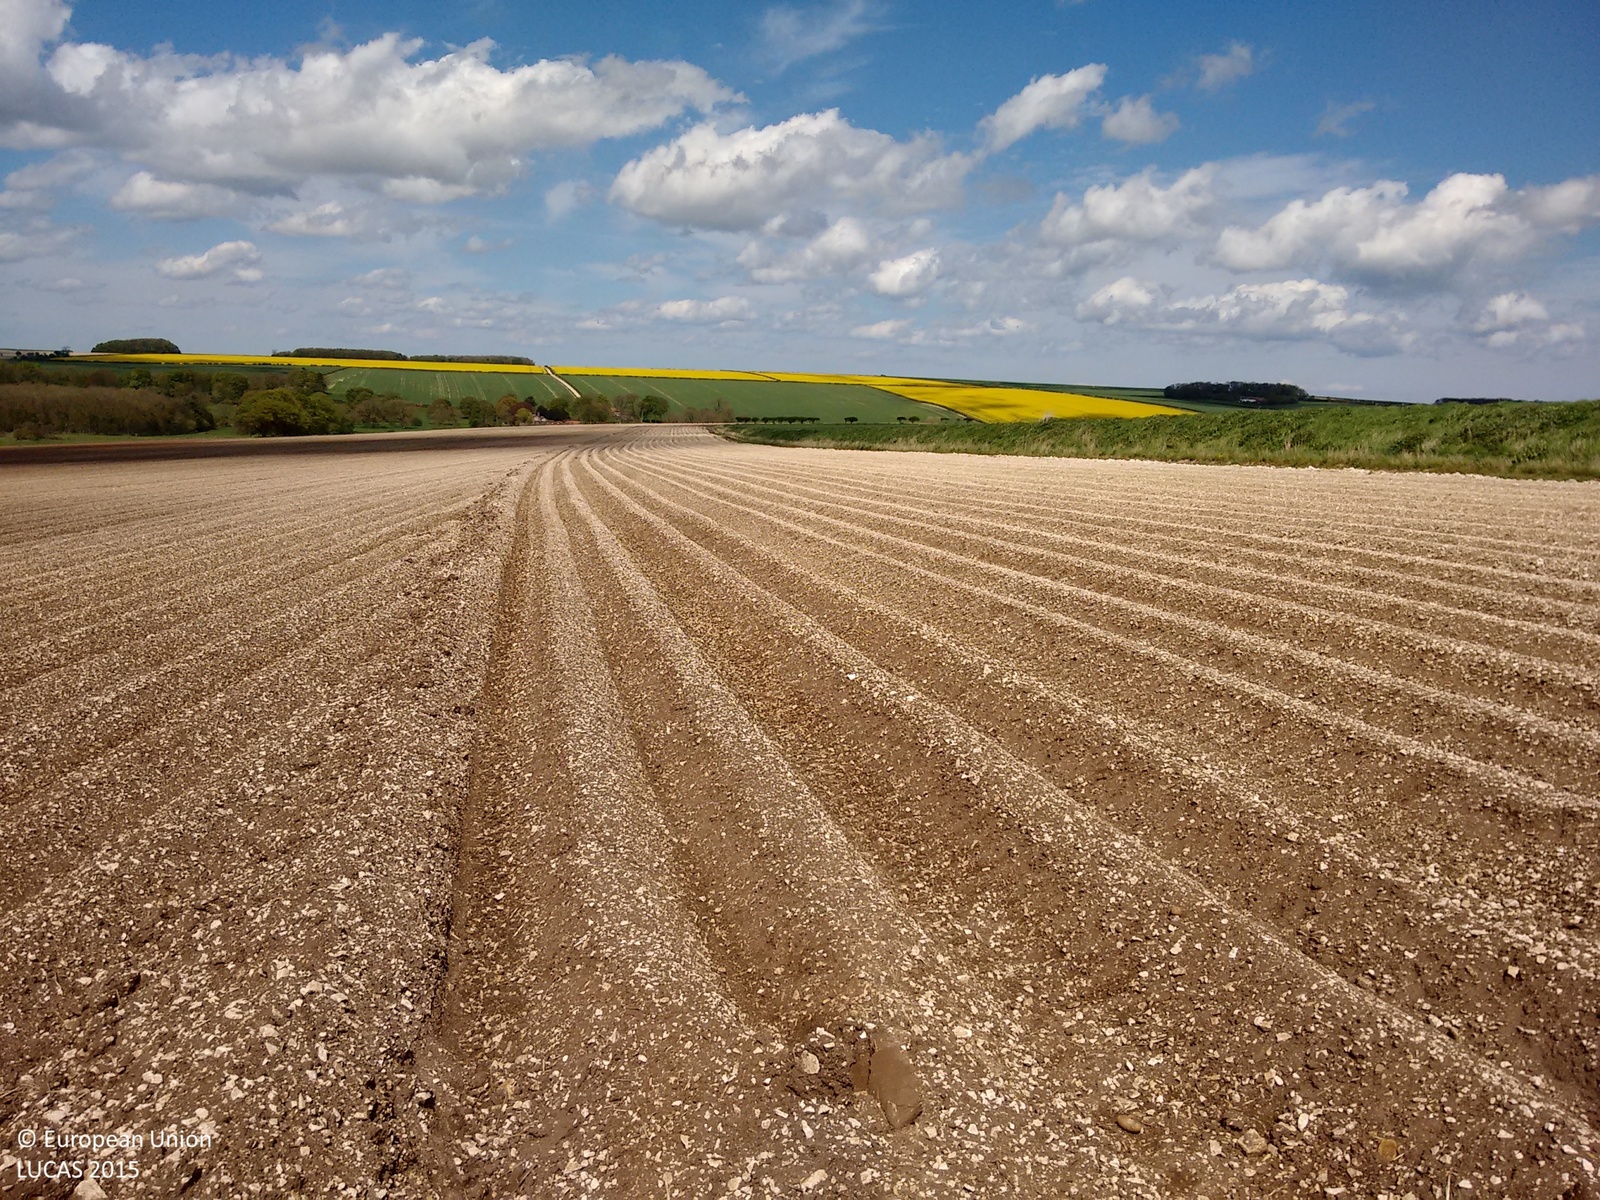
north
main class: Cropland
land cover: Potatoes
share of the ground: < 10 %
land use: Agriculture (excluding fallow land and kitchen gardens)
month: May
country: GB
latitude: 54.0863
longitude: -0.2918
